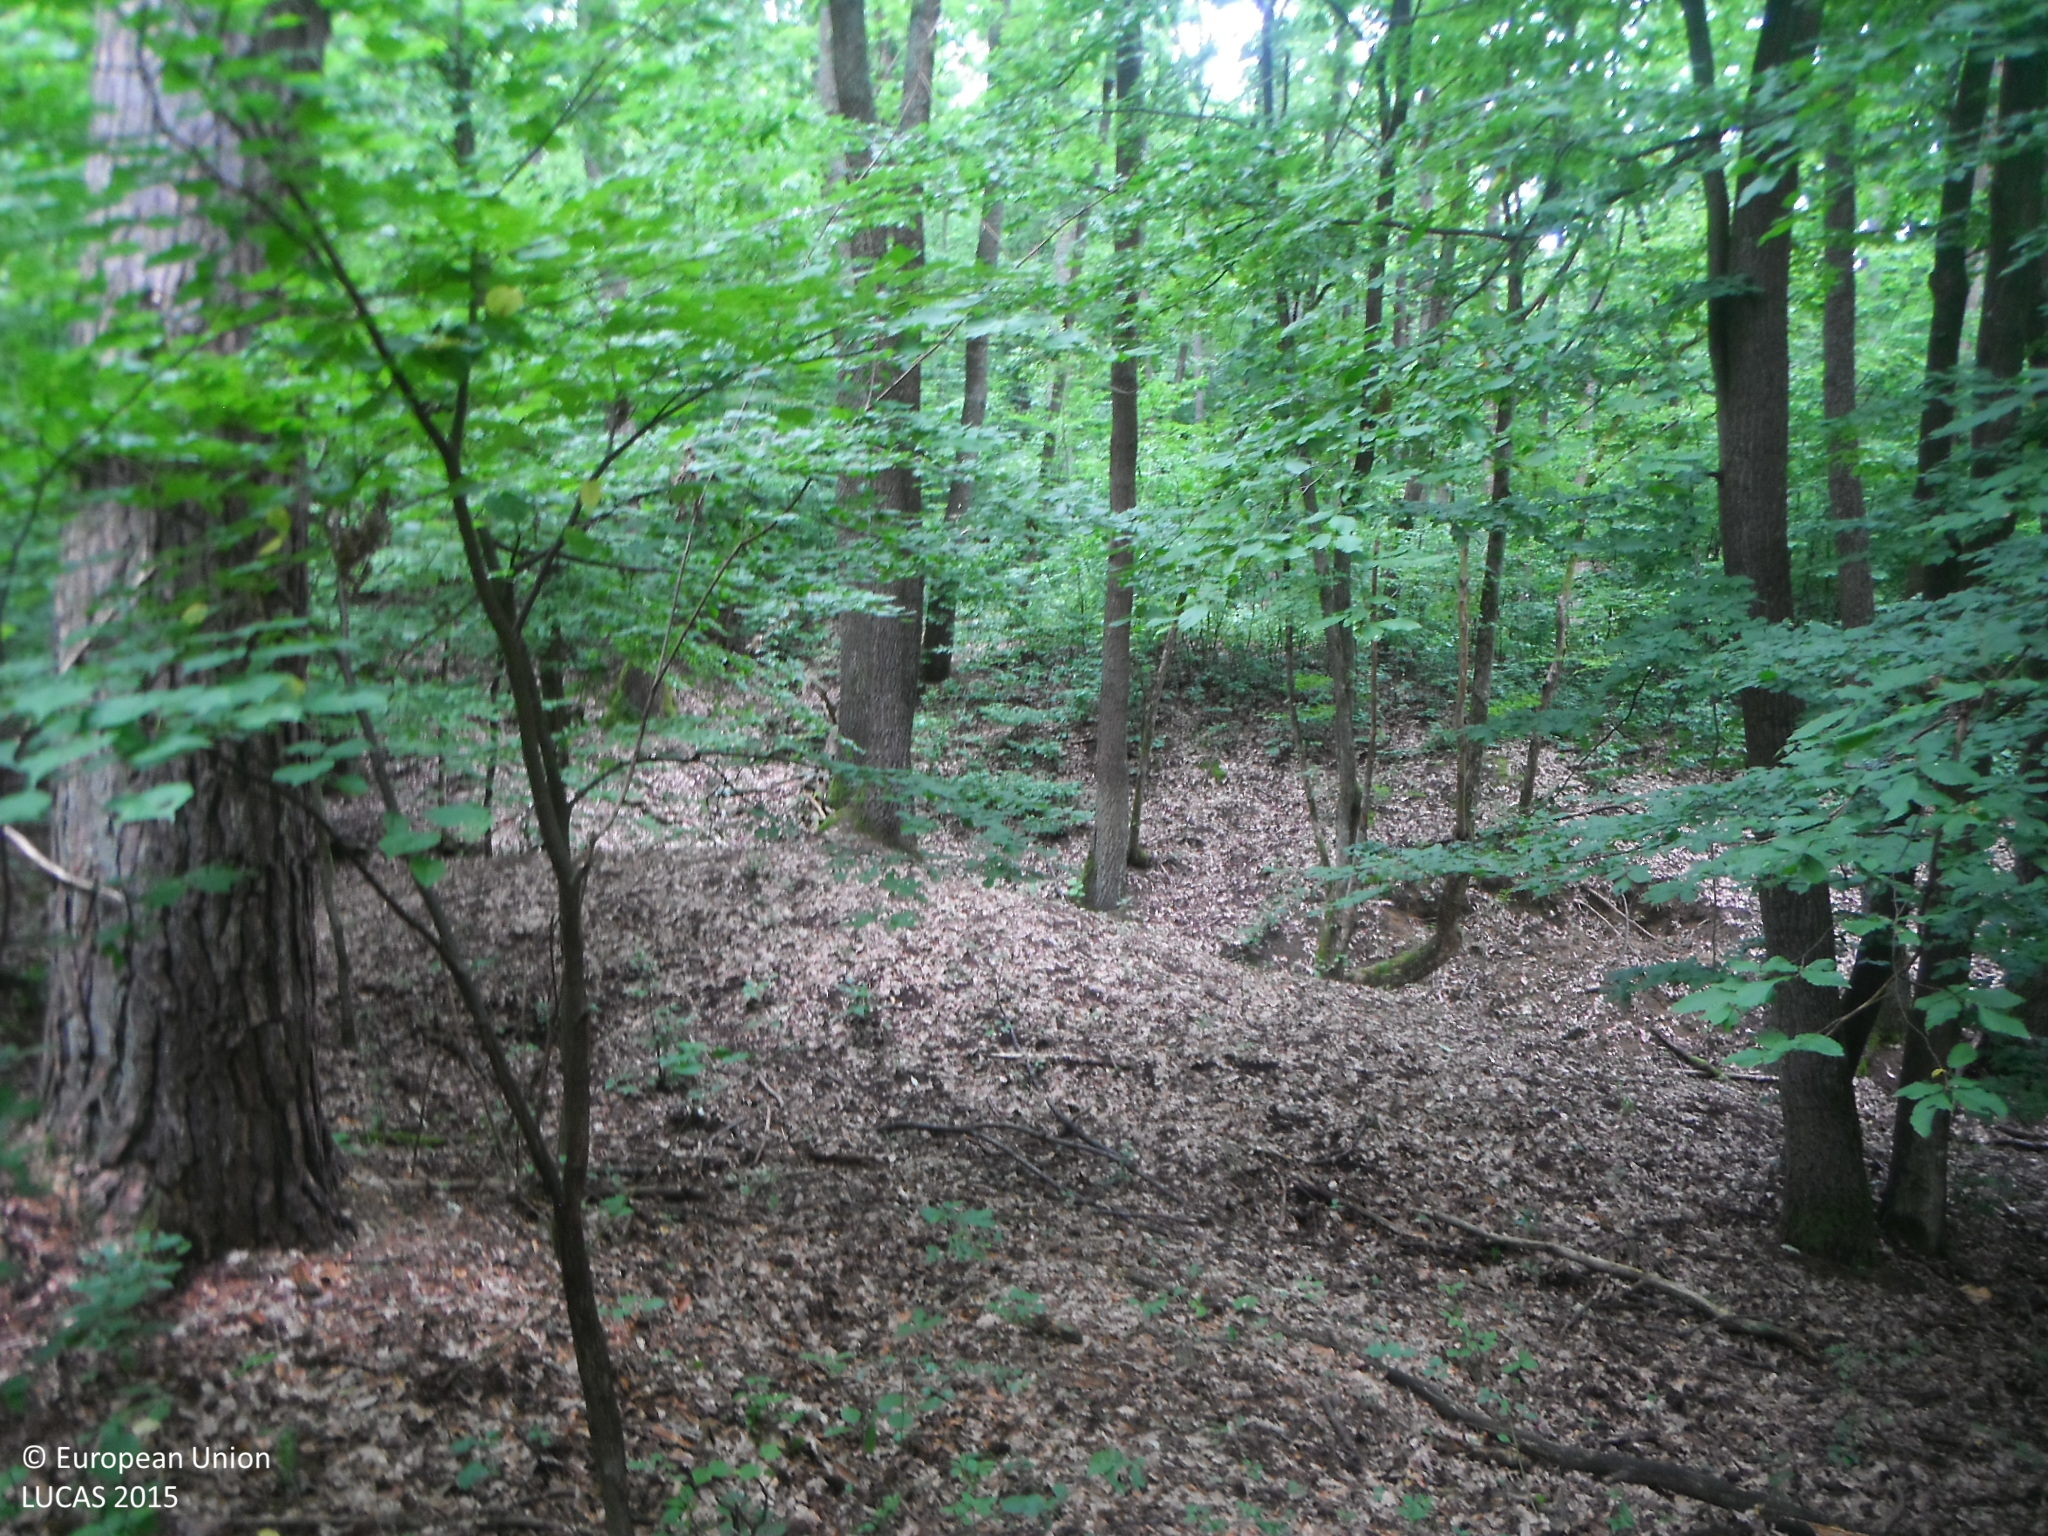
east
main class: Woodland
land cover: Broadleaved woodland
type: beech forest
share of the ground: > 75 %
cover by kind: broadleaved forest trees 100 %
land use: Forestry
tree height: > 5 m
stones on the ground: > 50 %
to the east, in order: Broadleaved woodland; Grassland without tree/shrub cover; Tracks; Grassland without tree/shrub cover
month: June
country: SK
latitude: 48.4730
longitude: 20.2172
